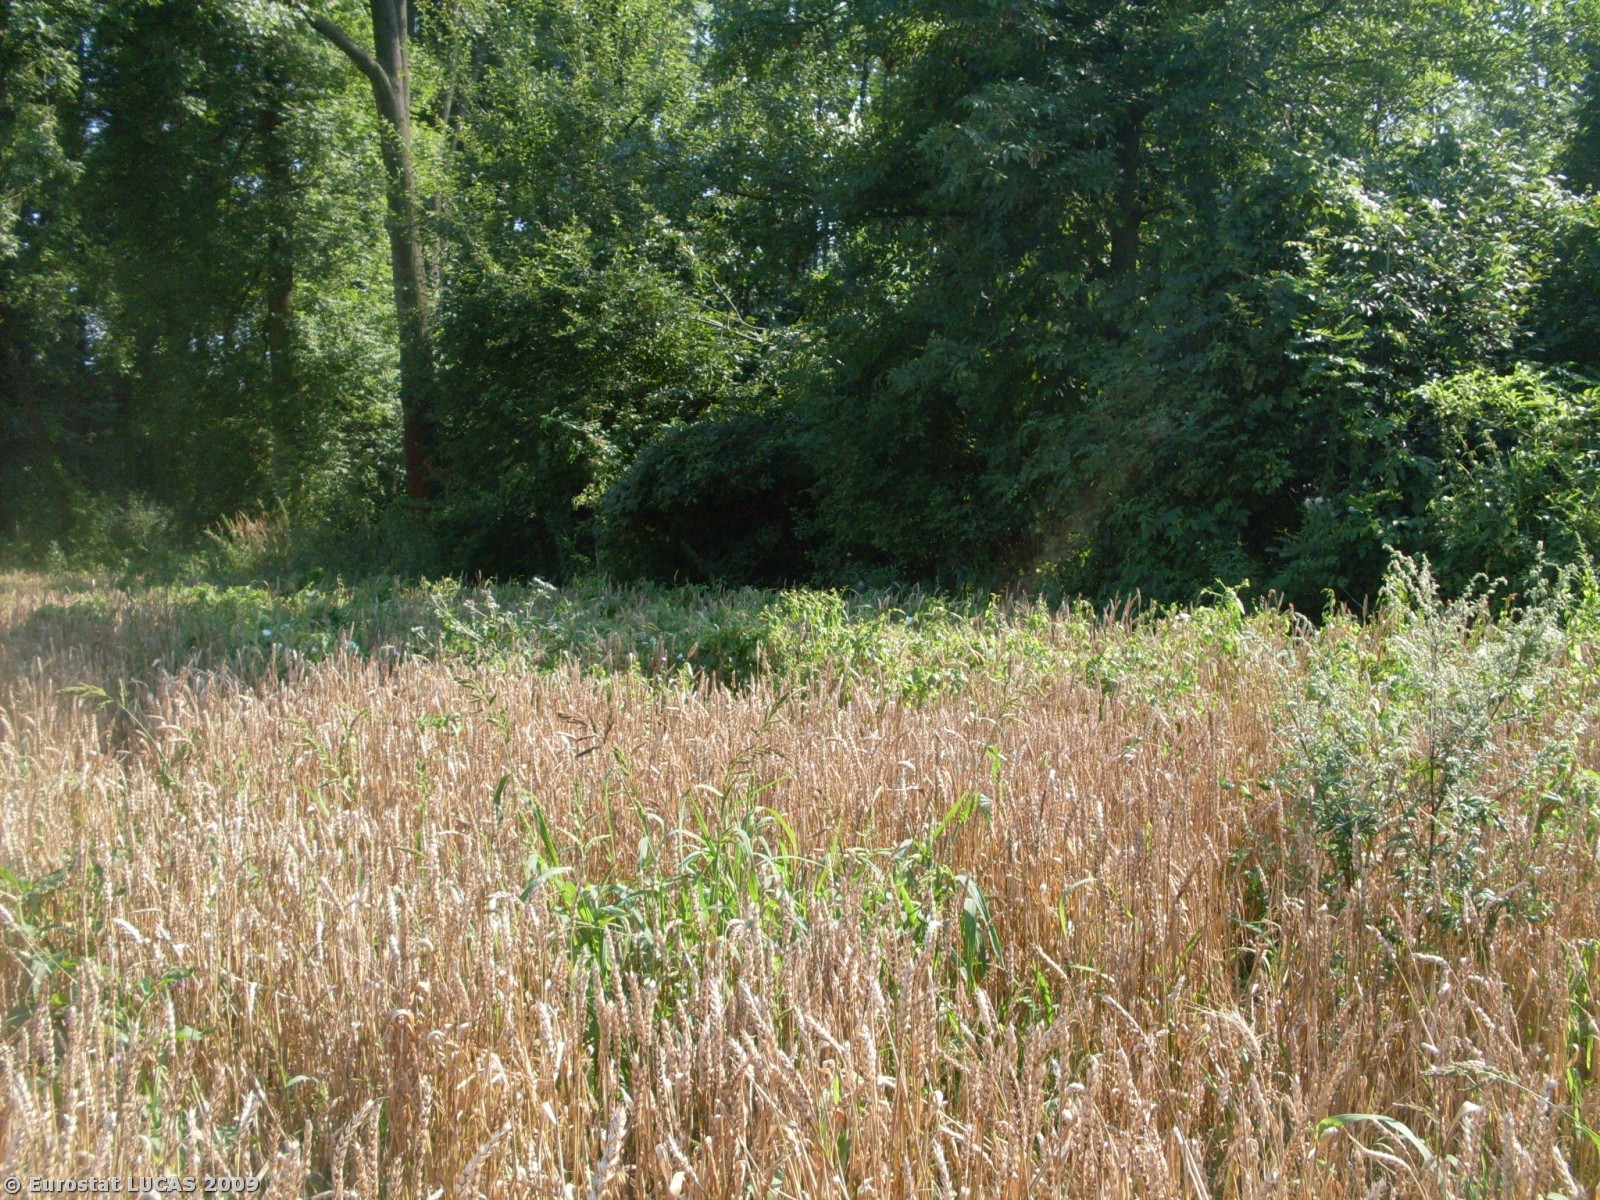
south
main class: Cropland
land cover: Common wheat
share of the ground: > 75 %
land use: Agriculture (excluding fallow land and kitchen gardens)
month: August
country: PL
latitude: 49.9438
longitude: 20.5872
